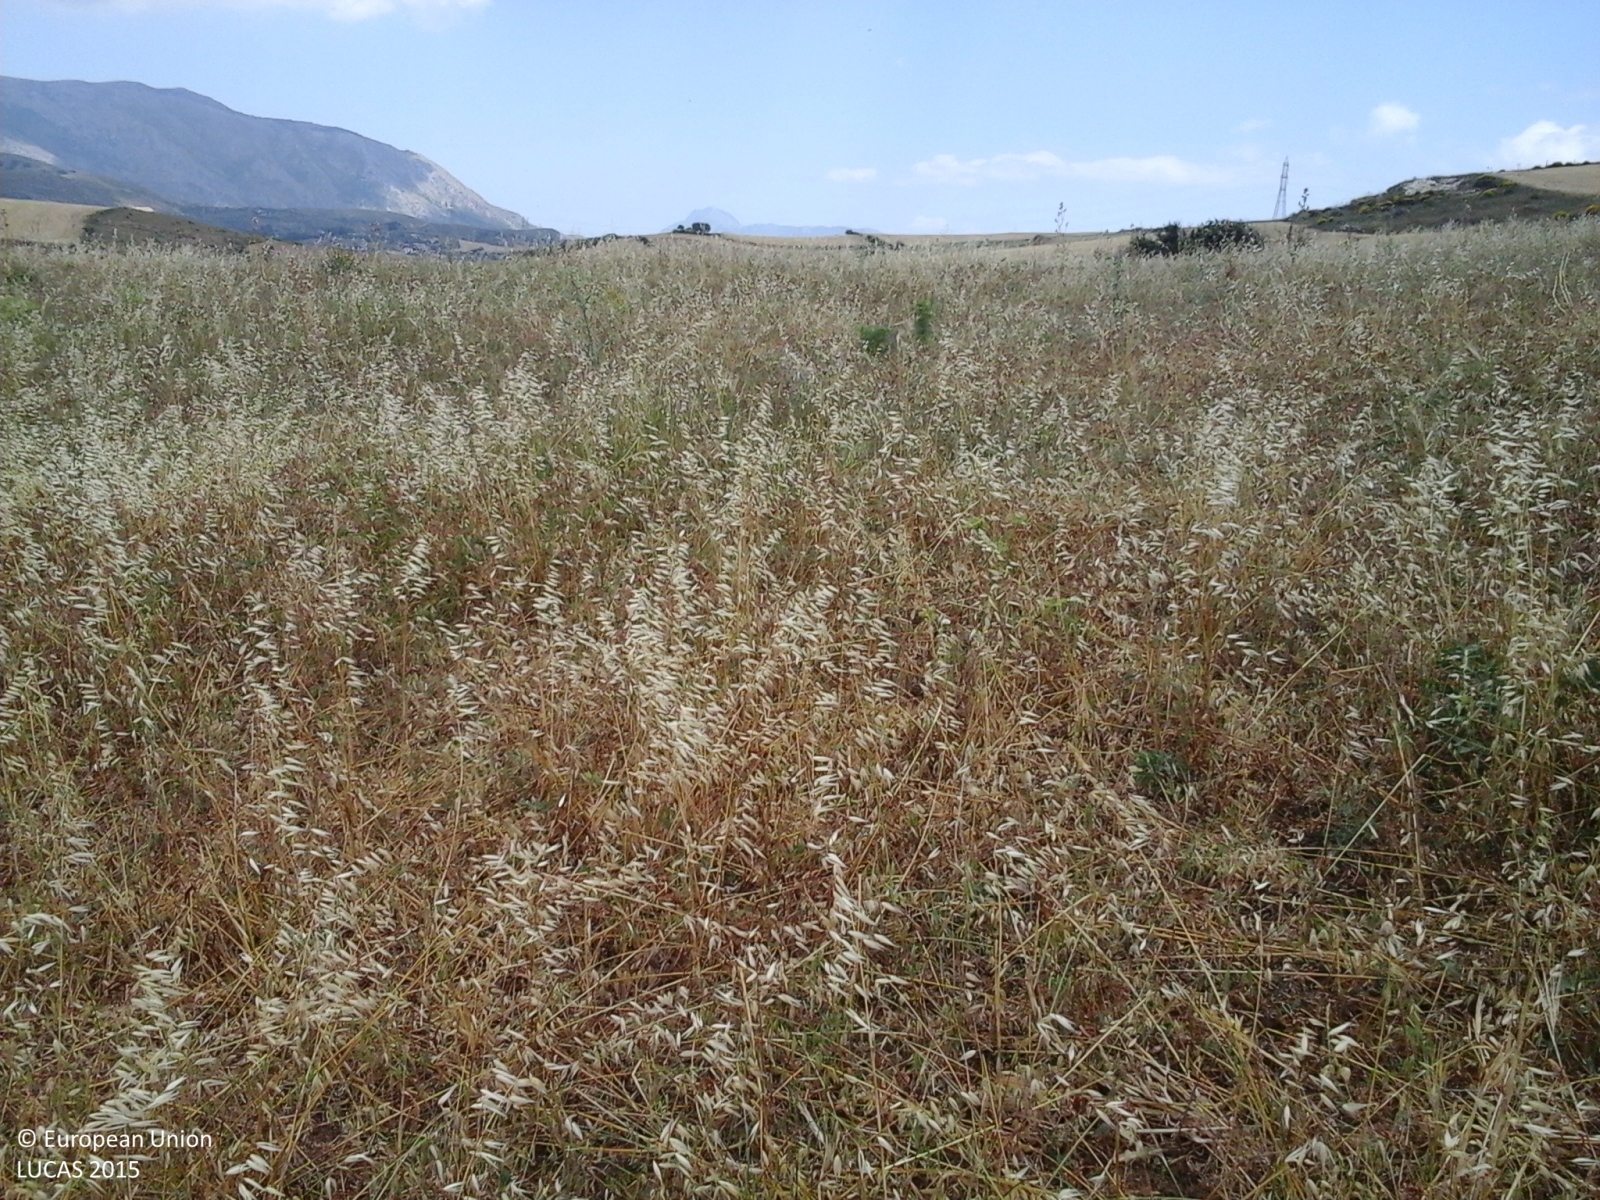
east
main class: Grassland
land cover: Spontaneously vegetated surfaces
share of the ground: > 75 %
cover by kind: herbaceous plants 100 %
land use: Fallow land
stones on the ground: < 10 %
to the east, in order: Spontaneously vegetated surfaces; Ditches and canals; Durum wheat; Ditches and canals
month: June
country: IT
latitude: 37.9007
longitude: 13.5117
